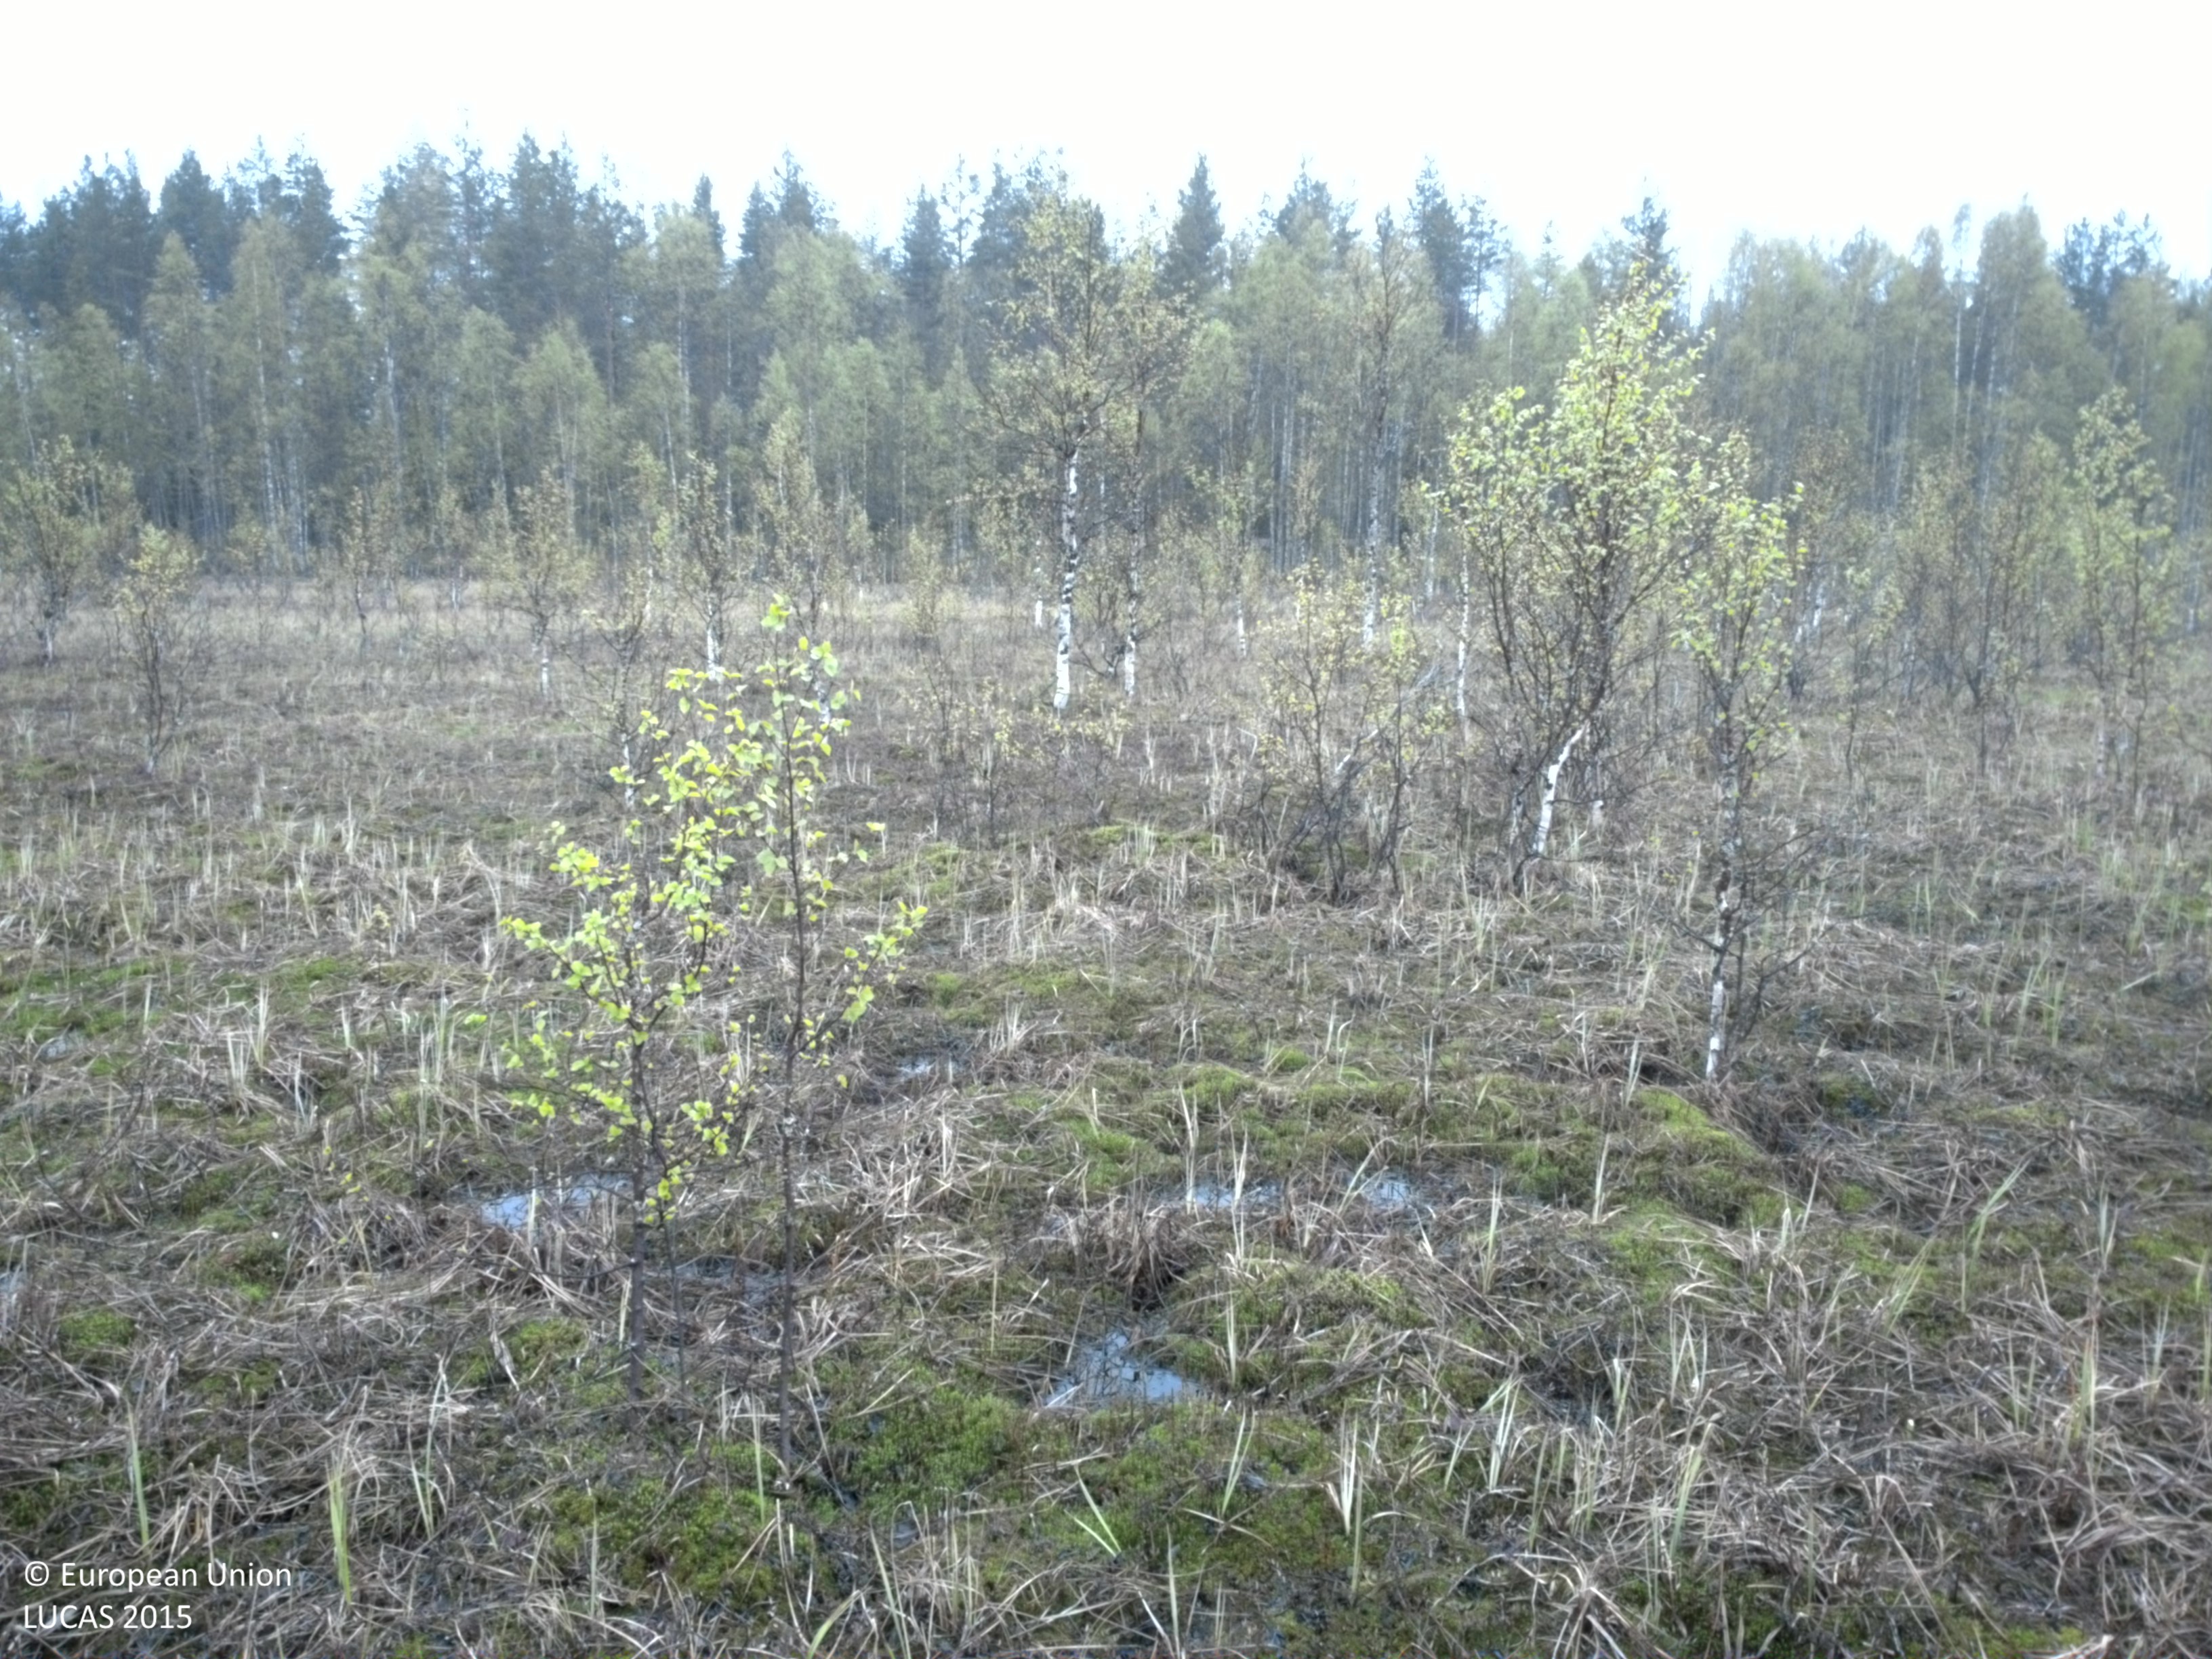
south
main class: Woodland
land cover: Broadleaved woodland
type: mire and swamp forests
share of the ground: 50 - 75 %
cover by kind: broadleaved forest trees 50 %, lichens and mosses 40 %, herbaceous plants 10 %
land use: Semi-natural and natural areas not in use
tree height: < 5 m
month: June
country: SE
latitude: 65.9253
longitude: 23.1466
